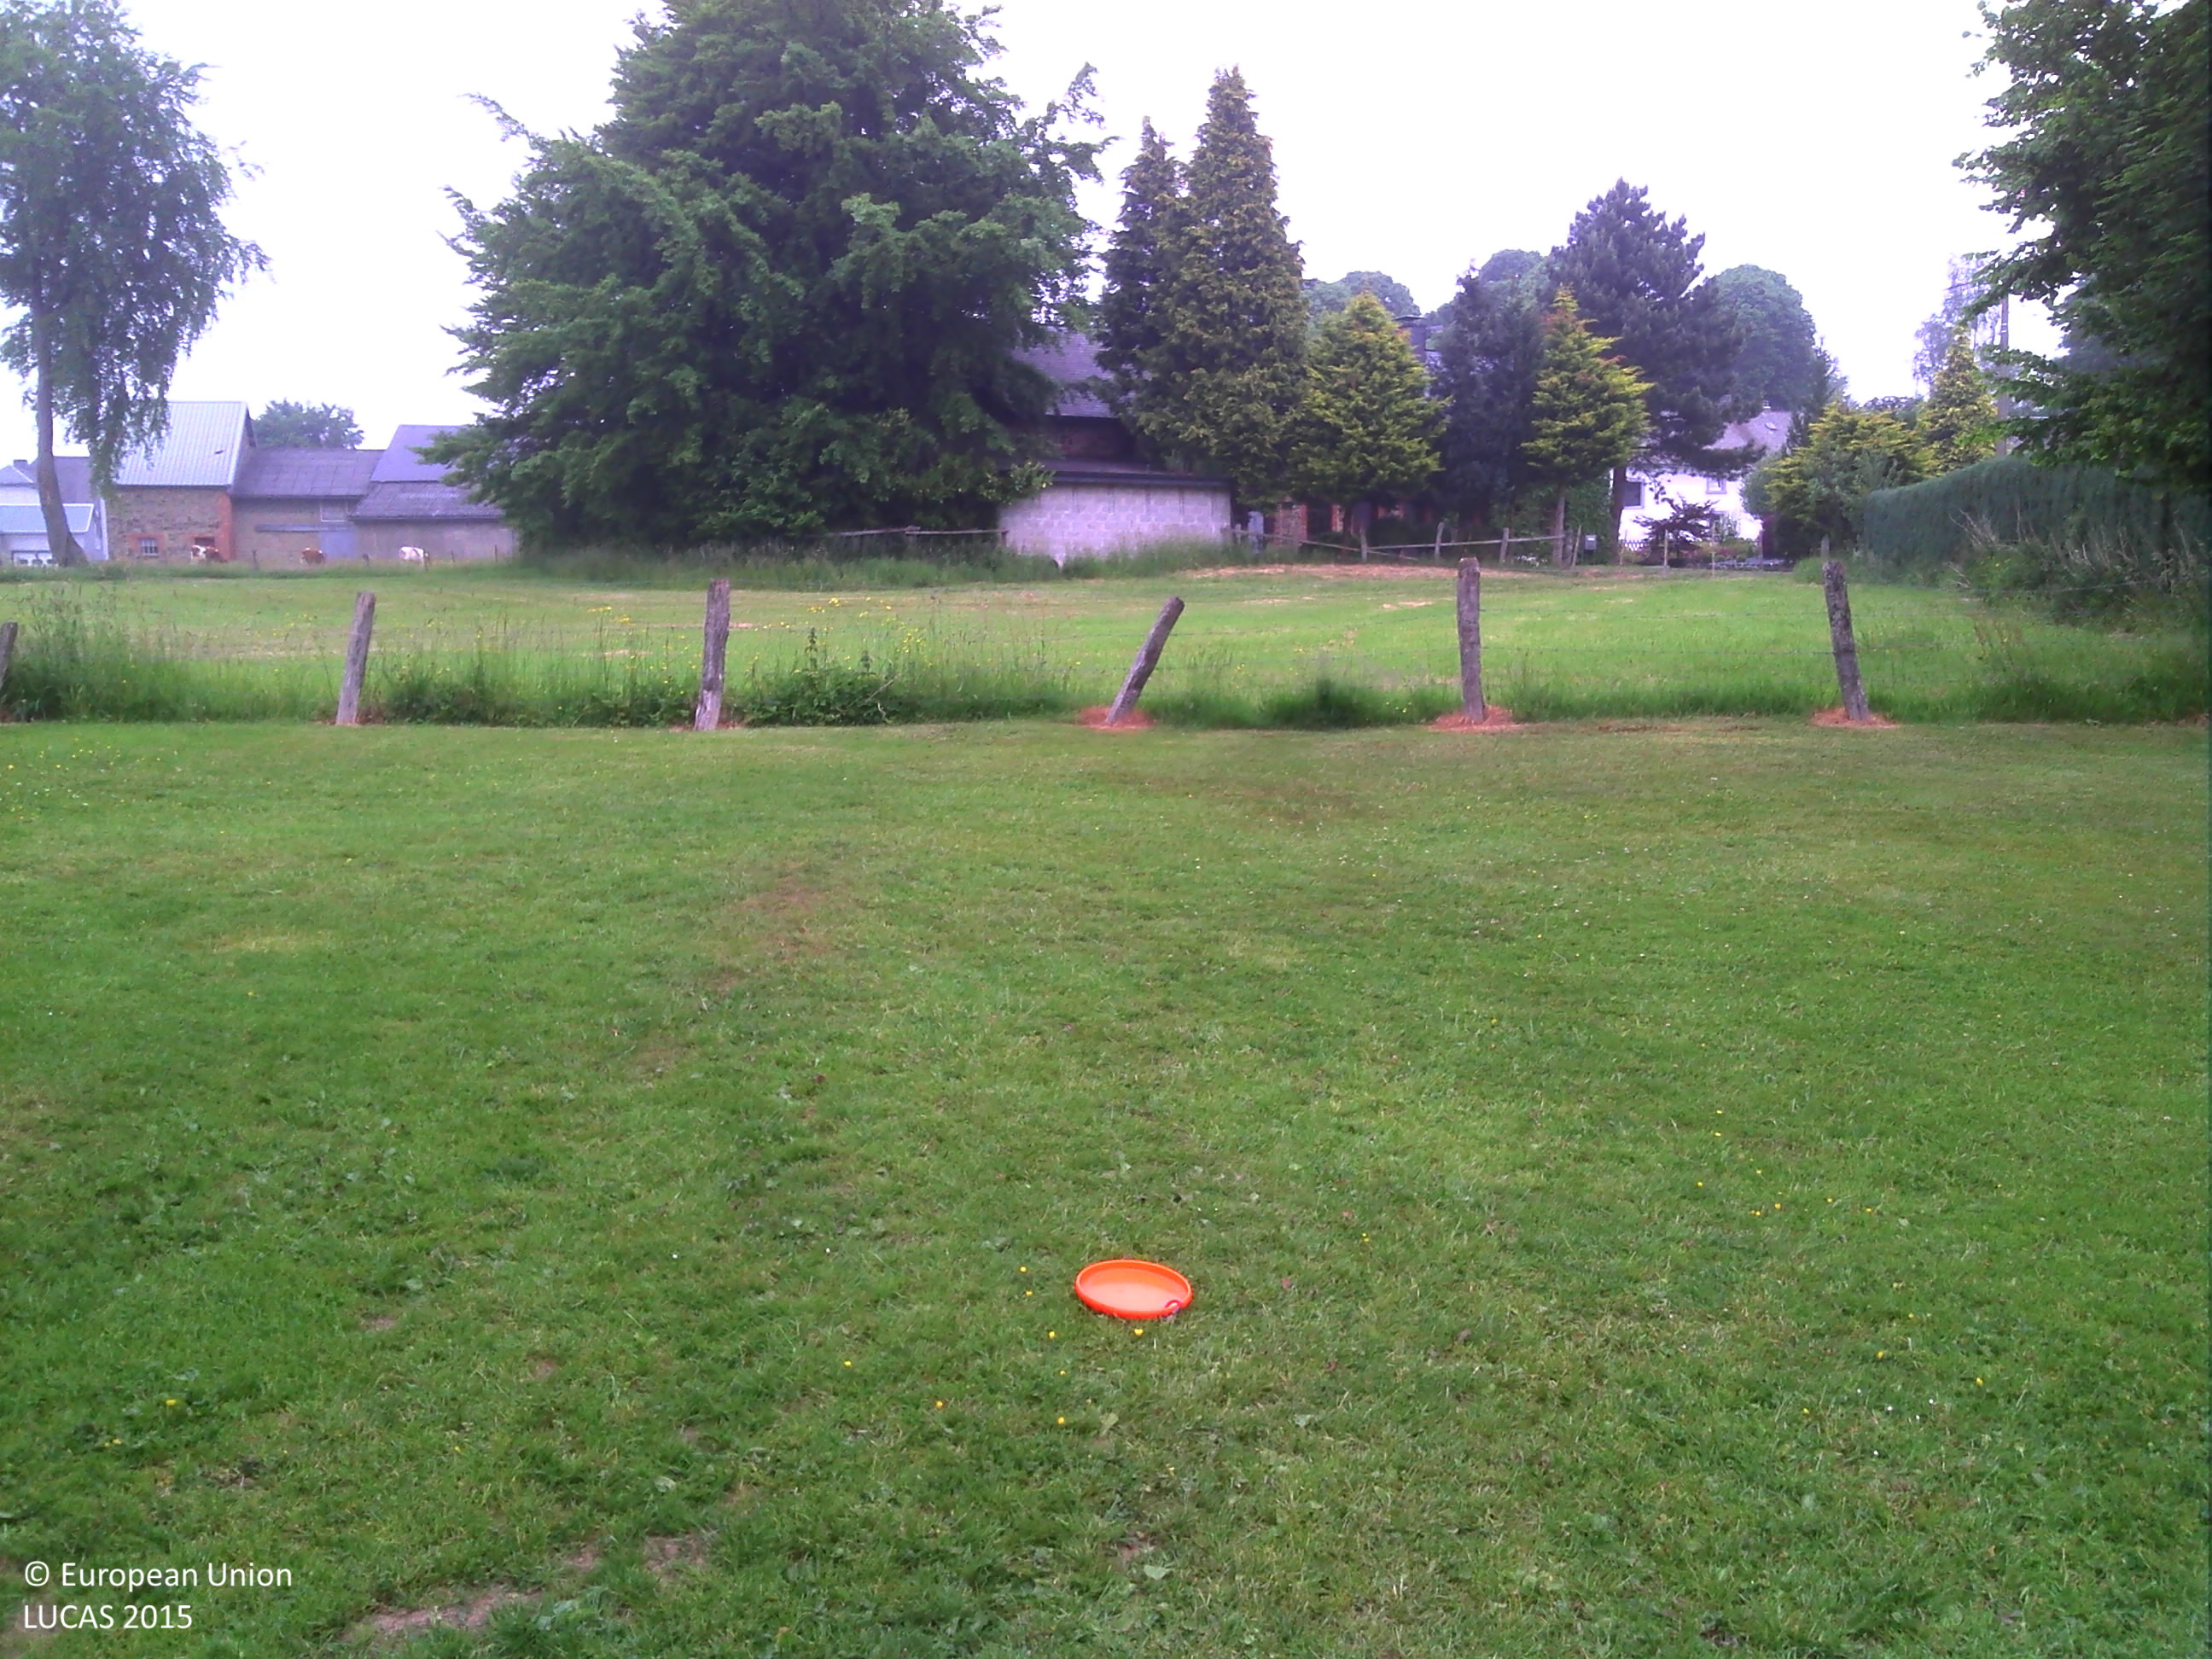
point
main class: Grassland
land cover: Grassland without tree/shrub cover
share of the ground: > 75 %
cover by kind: herbaceous plants 100 %
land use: Residential
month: June
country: BE
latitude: 50.4301
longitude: 6.2970
